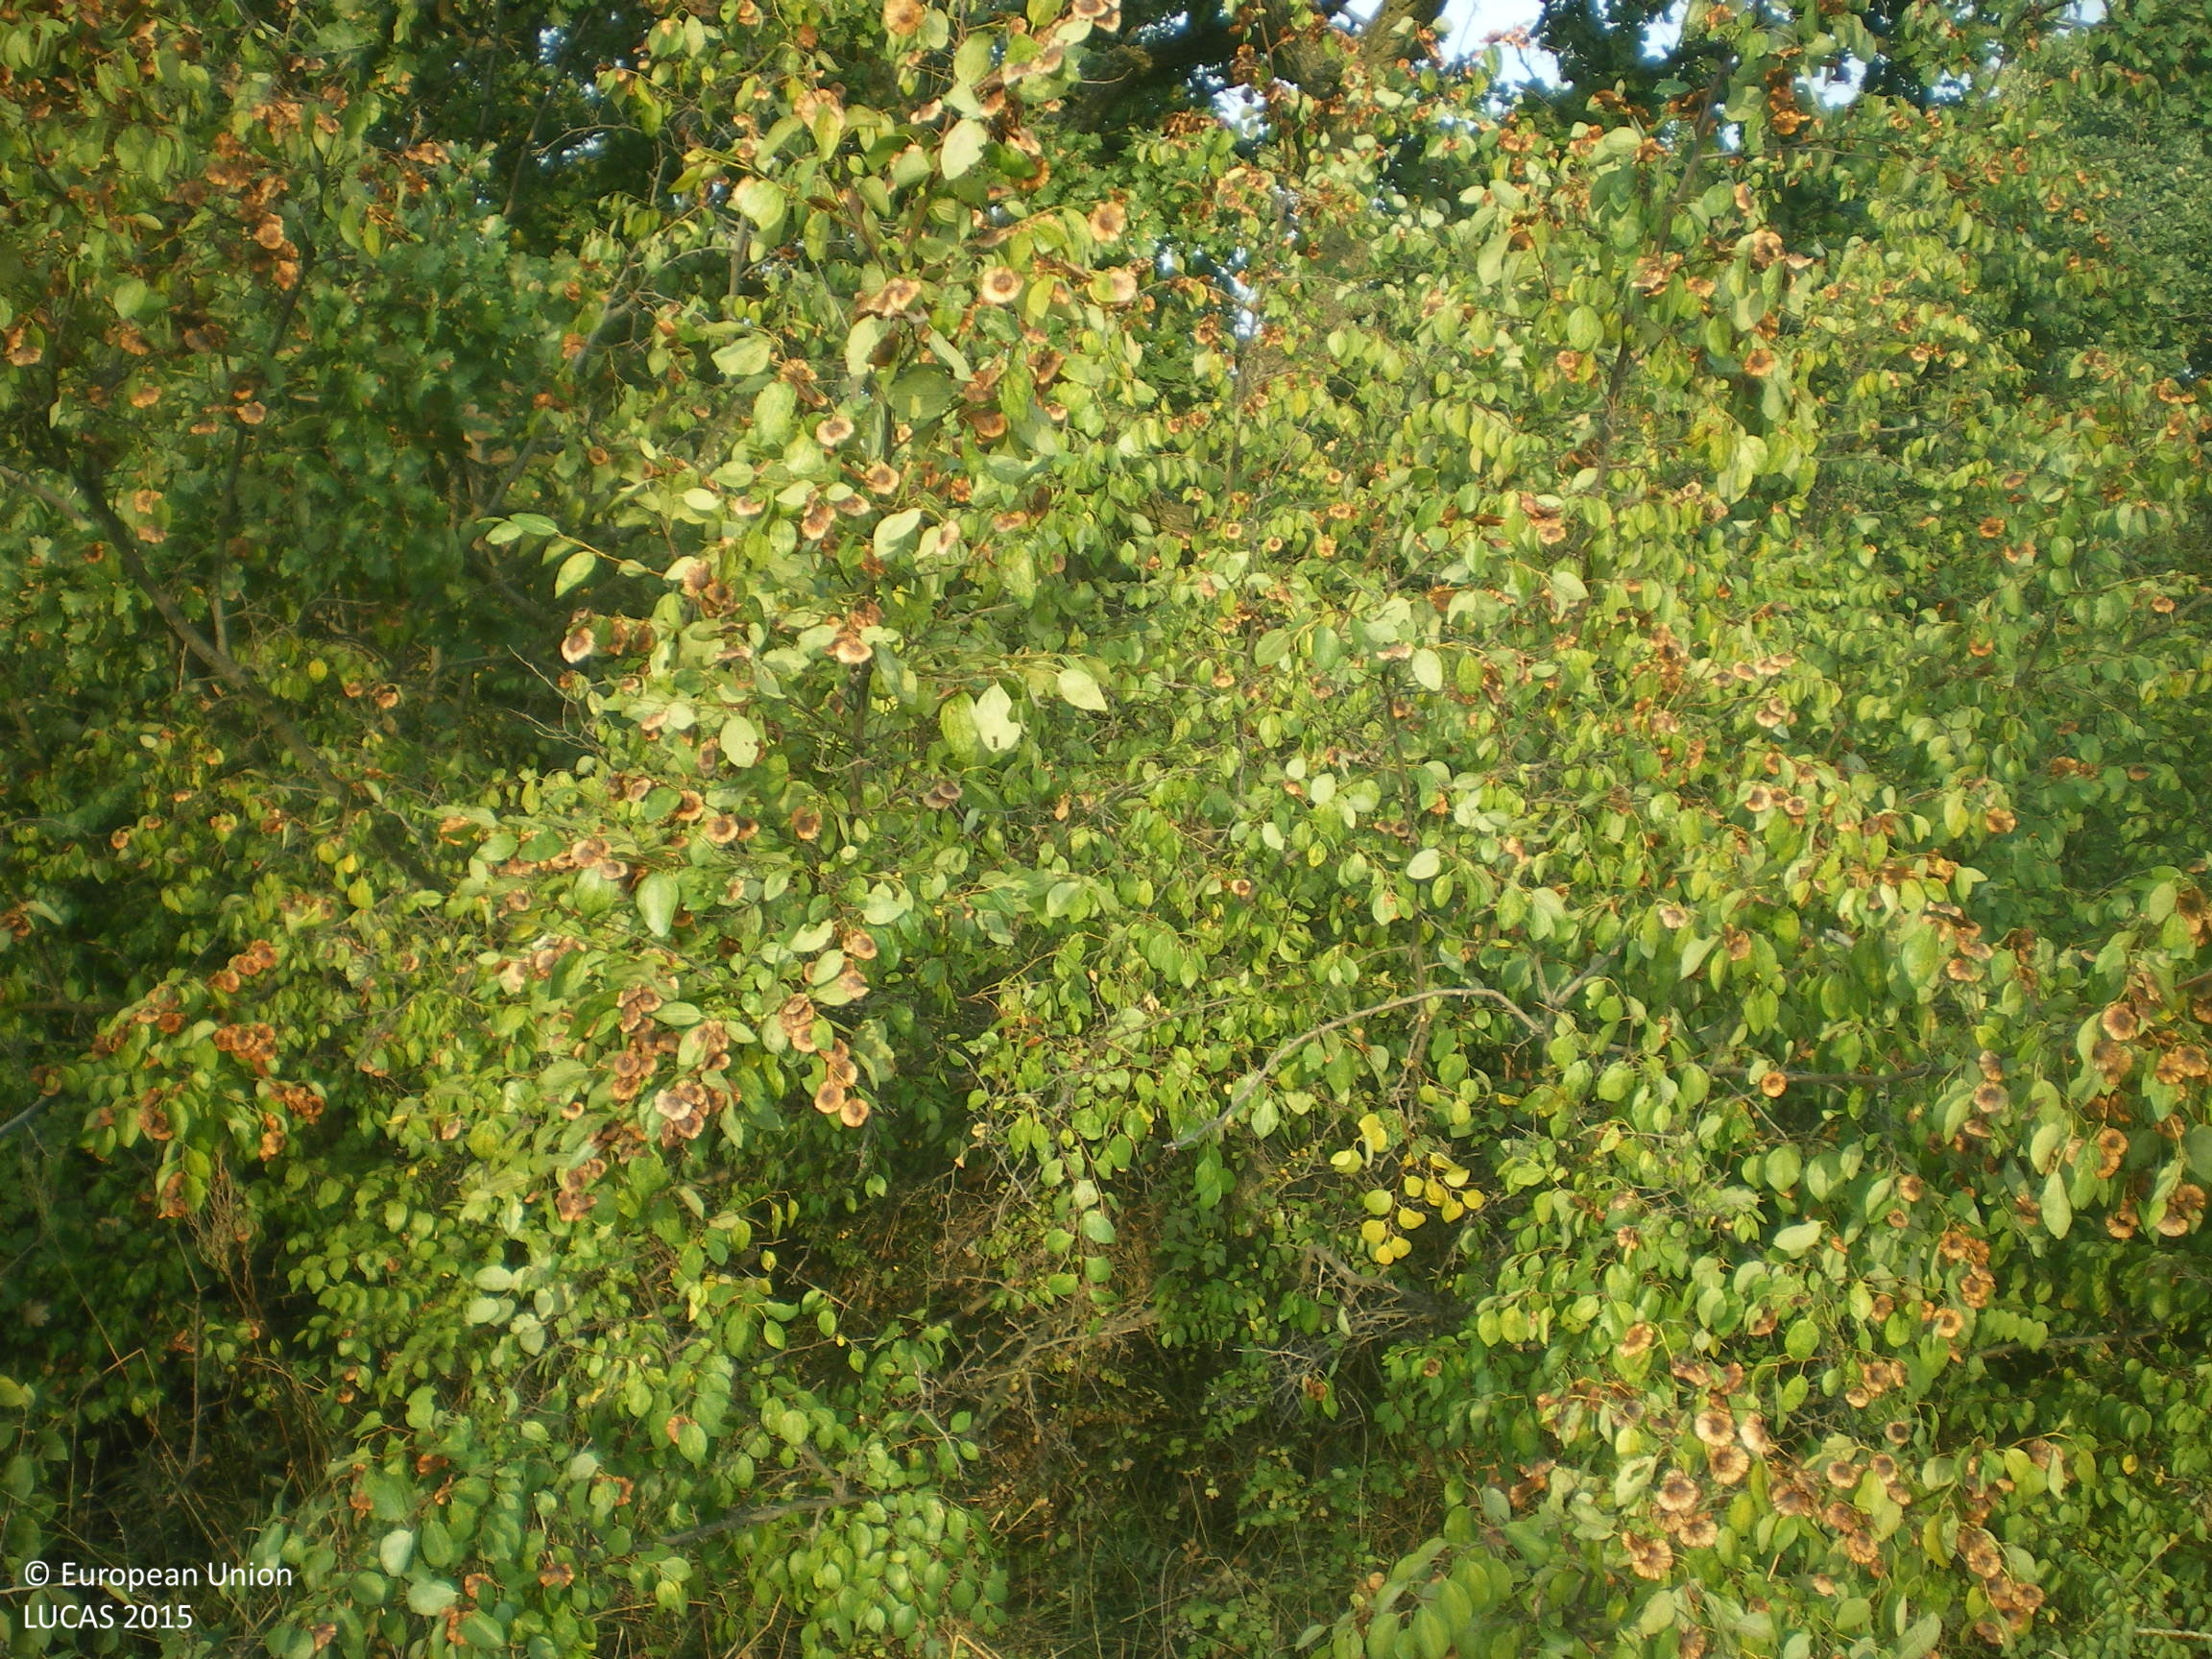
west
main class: Woodland
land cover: Broadleaved woodland
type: mesophytic deciduous forest
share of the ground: > 75 %
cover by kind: broadleaved forest trees 80 %, shrubs 20 %
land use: Forestry
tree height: > 5 m
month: September
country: BG
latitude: 42.0669
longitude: 25.7941
